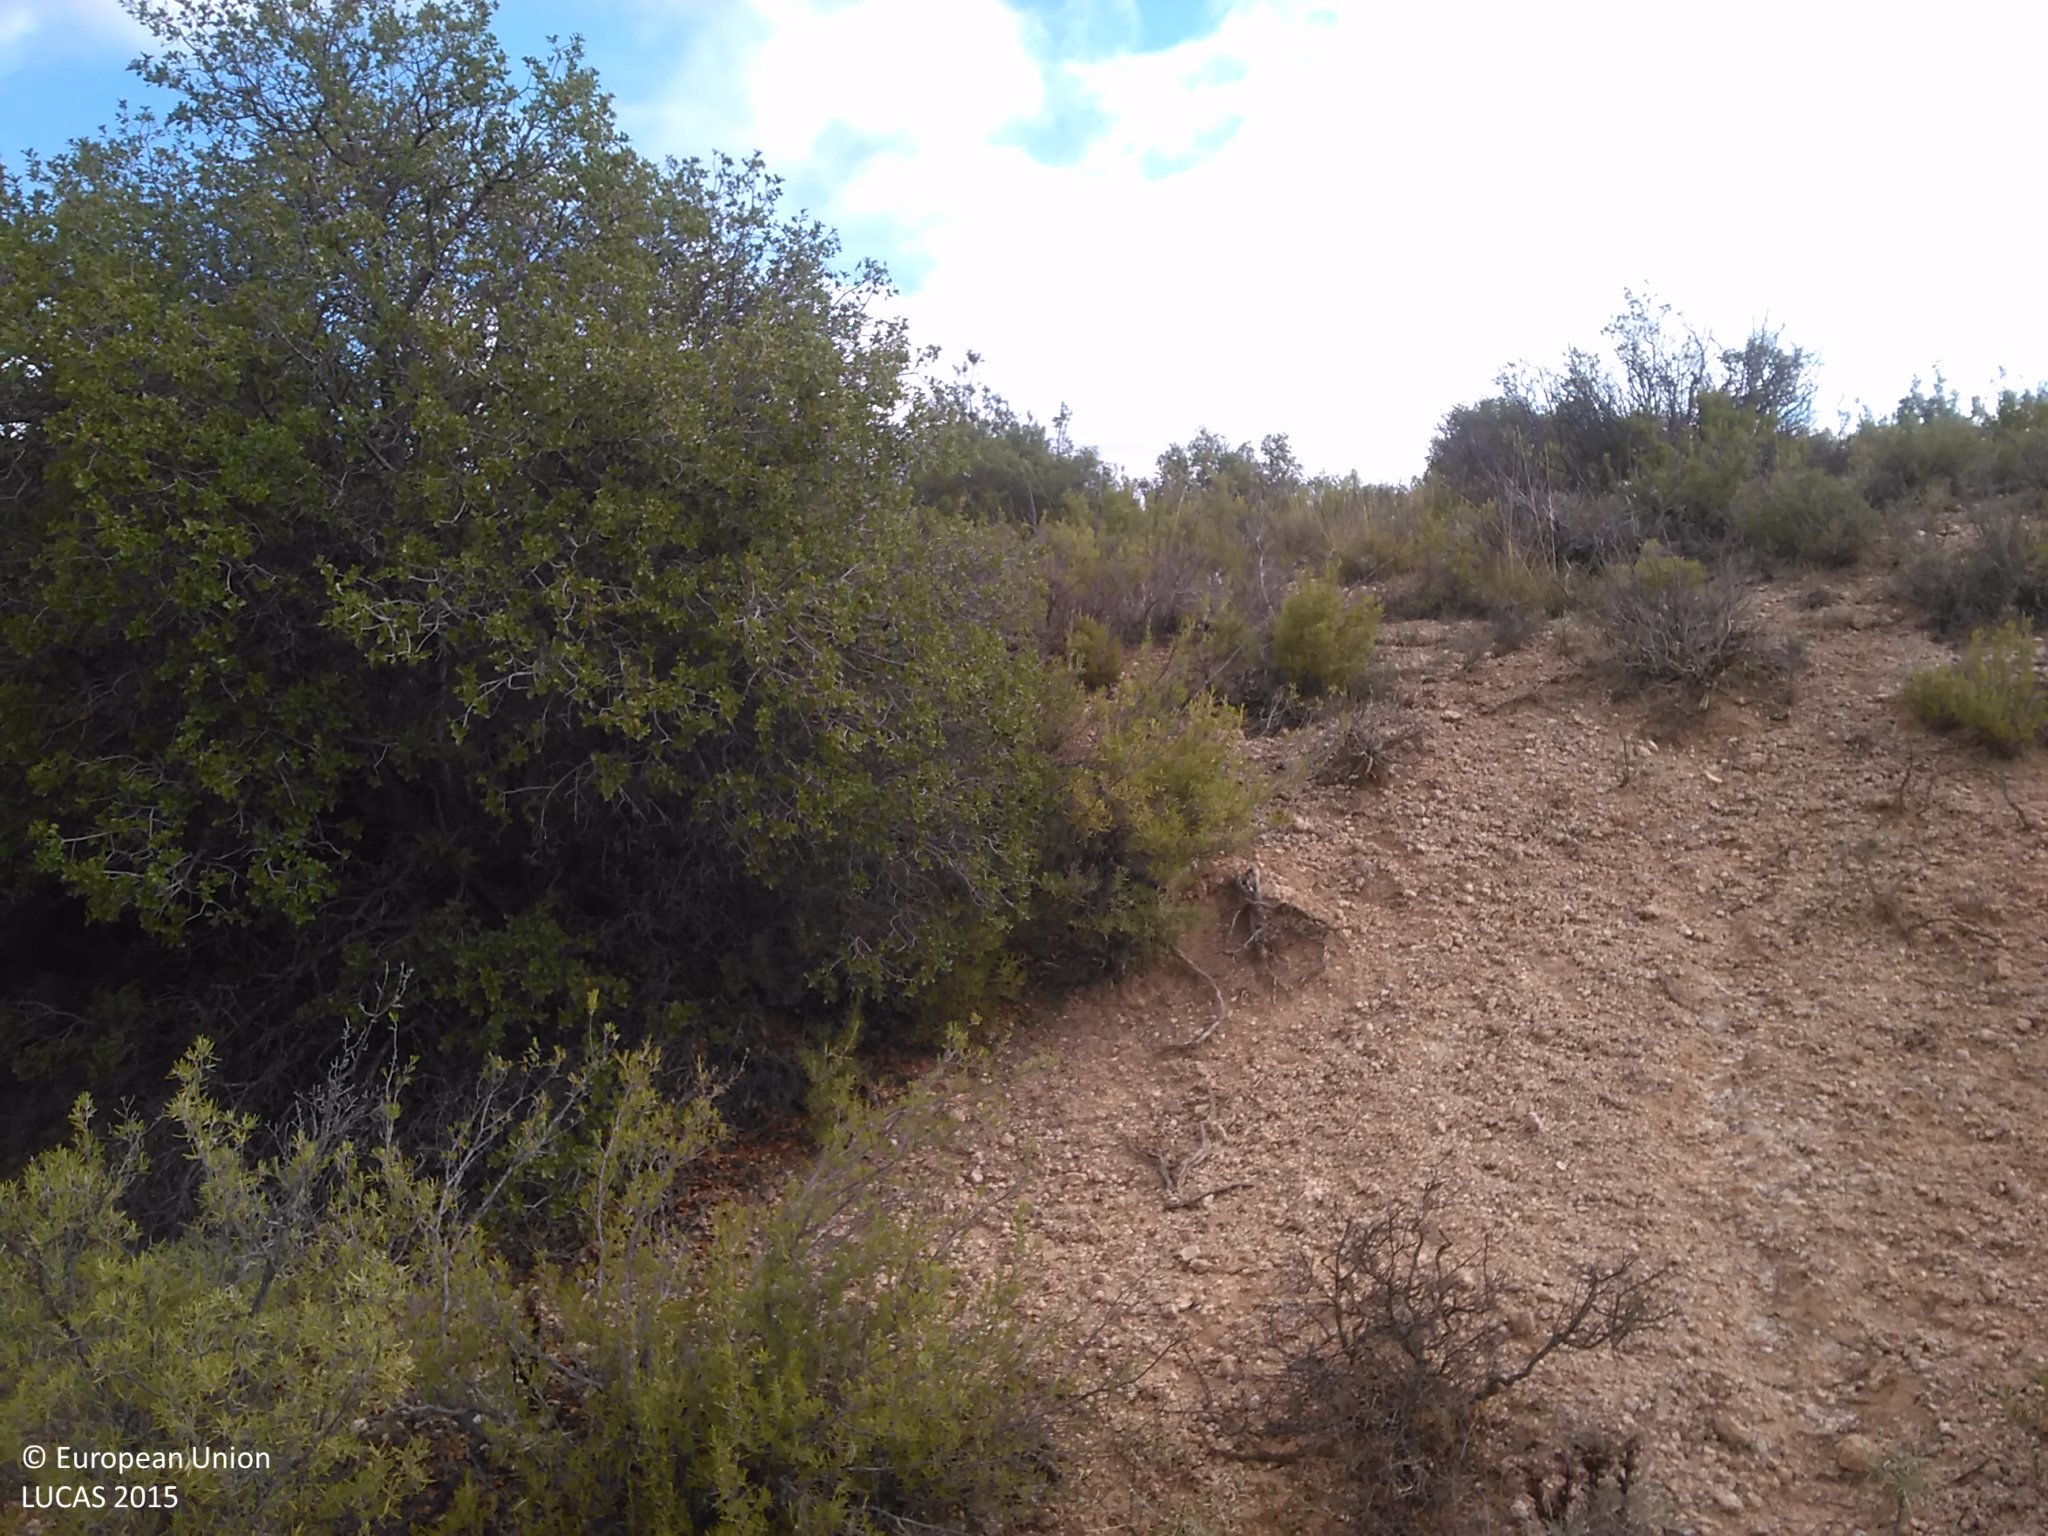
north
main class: Woodland
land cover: Other mixed woodland
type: coniferous forest of the mediterranean region
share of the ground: 25 - 50 %
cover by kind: shrubs 30 %, unconsolidated bare surface 25 %, coniferous forest trees 20 %, broadleaved forest trees 20 %, herbaceous plants 5 %
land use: Semi-natural and natural areas not in use
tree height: < 5 m
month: July
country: ES
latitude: 41.3548
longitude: -1.9934
